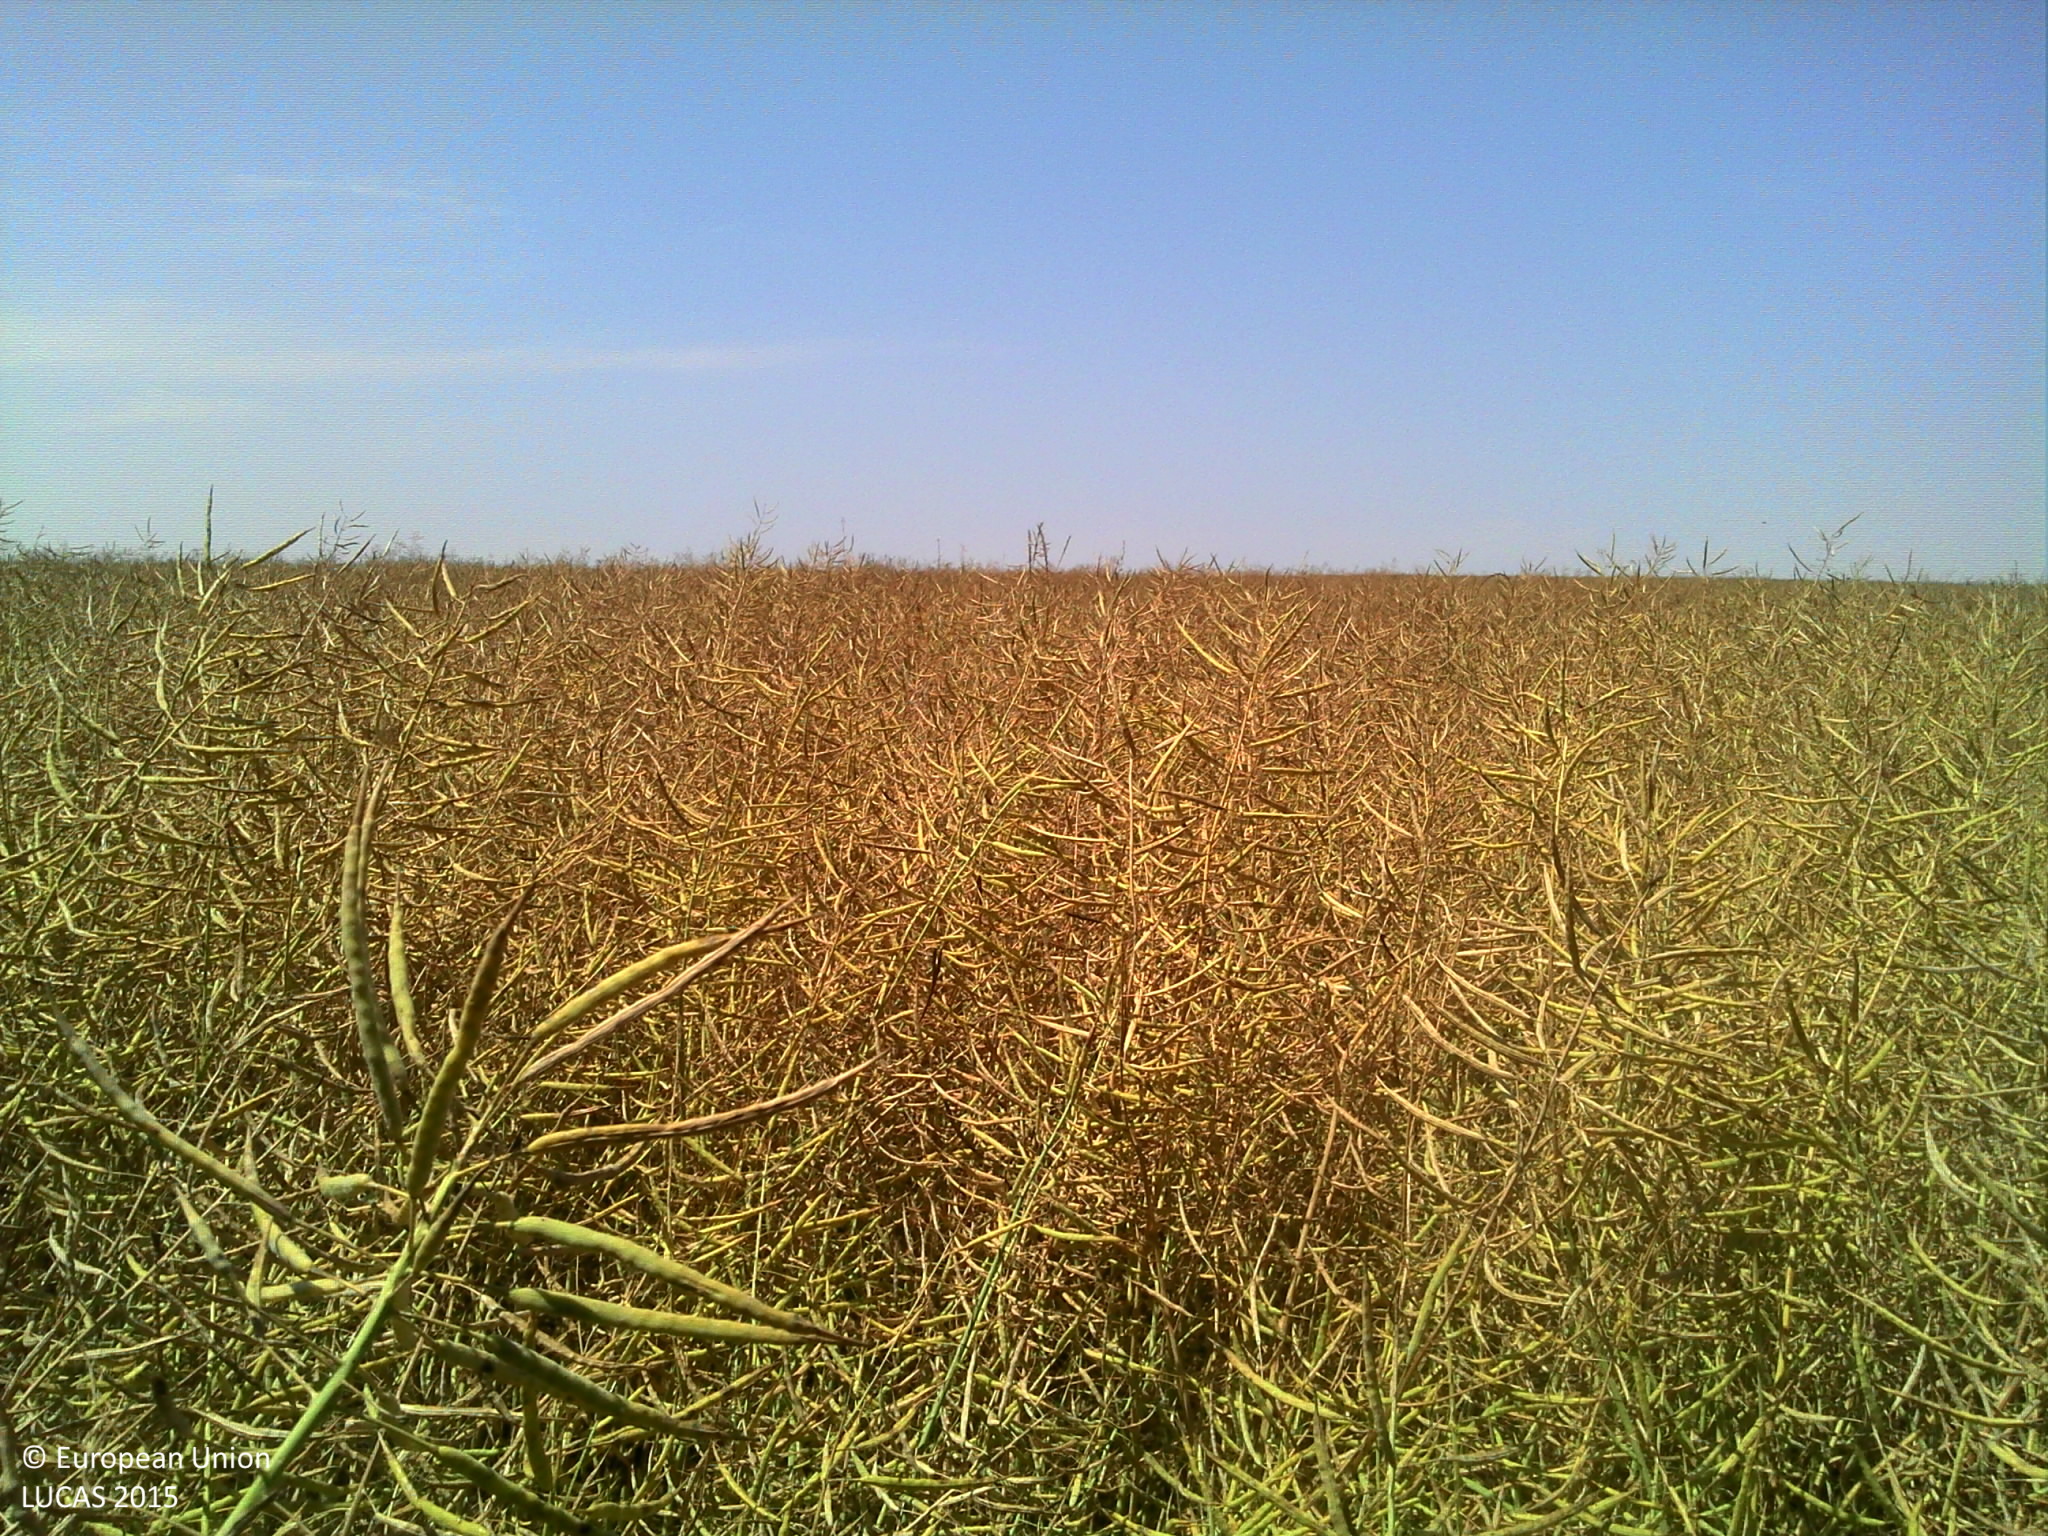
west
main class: Cropland
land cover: Rape and turnip rape
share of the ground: > 75 %
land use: Agriculture (excluding fallow land and kitchen gardens)
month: July
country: FR
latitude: 47.5130
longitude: 3.5829
